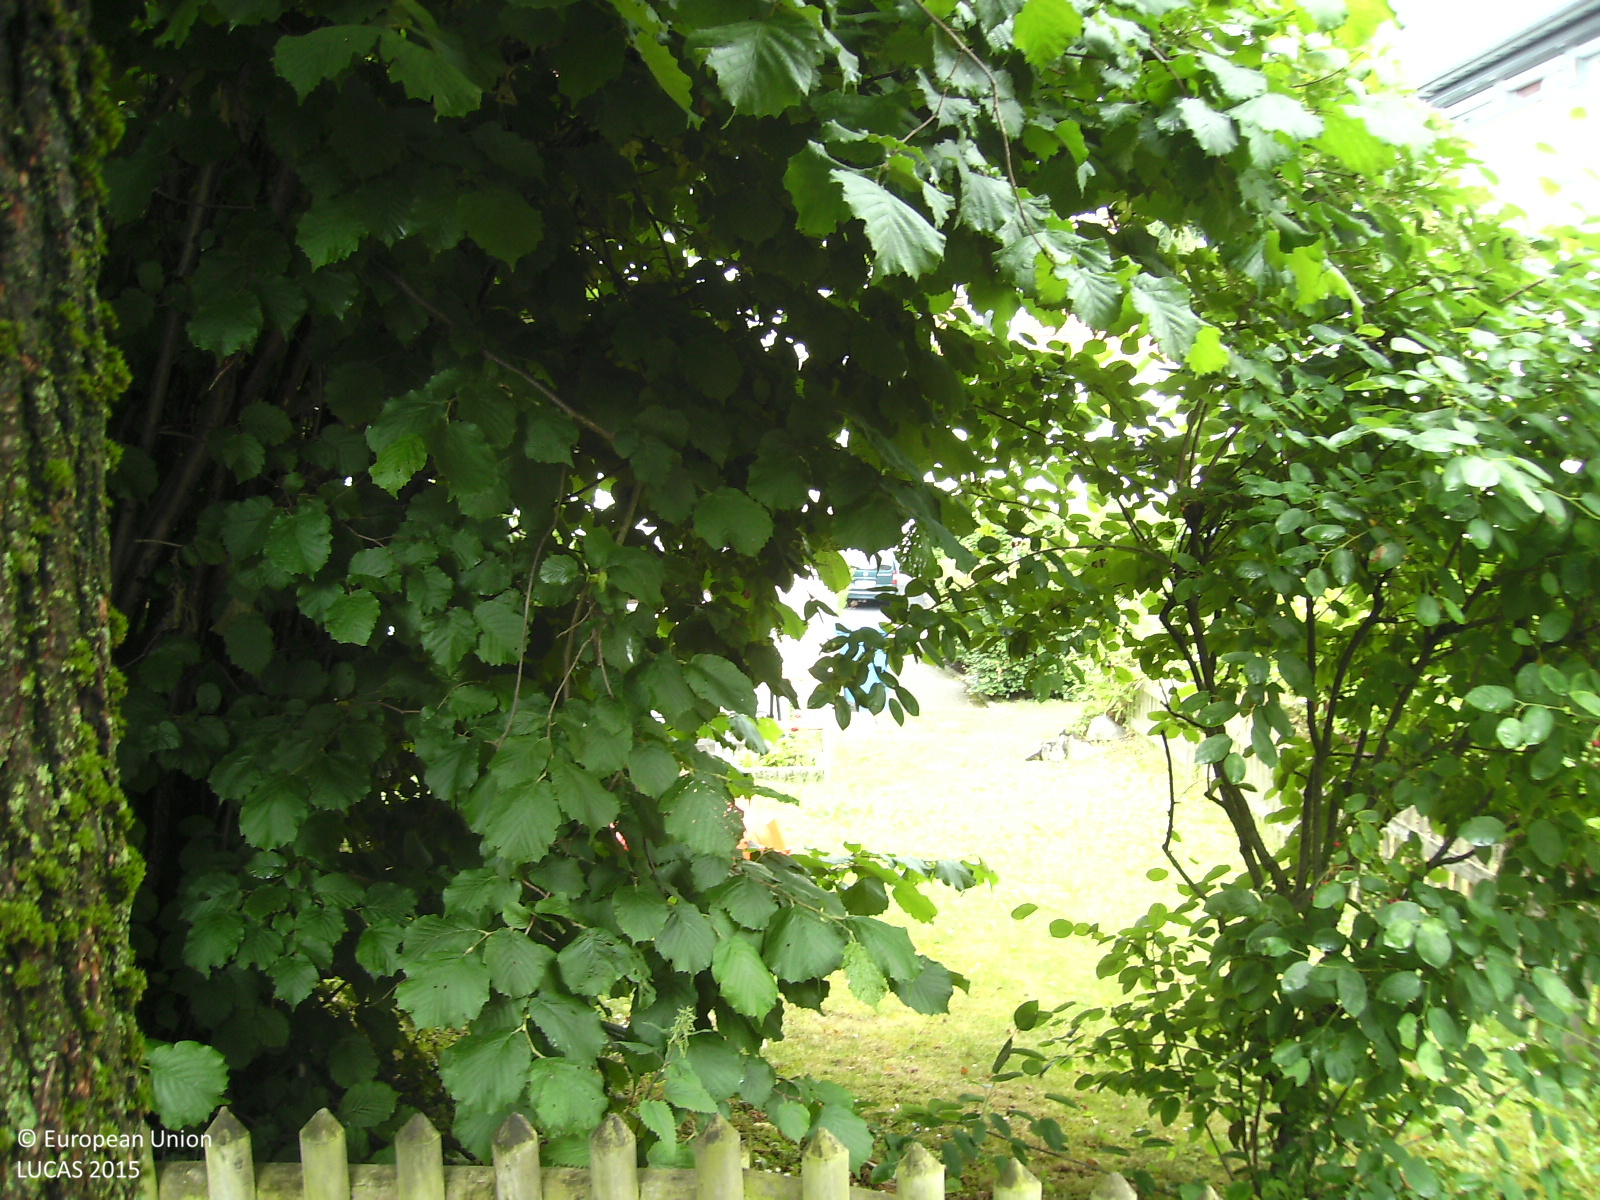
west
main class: Grassland
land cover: Grassland without tree/shrub cover
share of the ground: > 75 %
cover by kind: herbaceous plants 100 %
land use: Residential
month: June
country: DE
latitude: 51.2791
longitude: 7.0324
